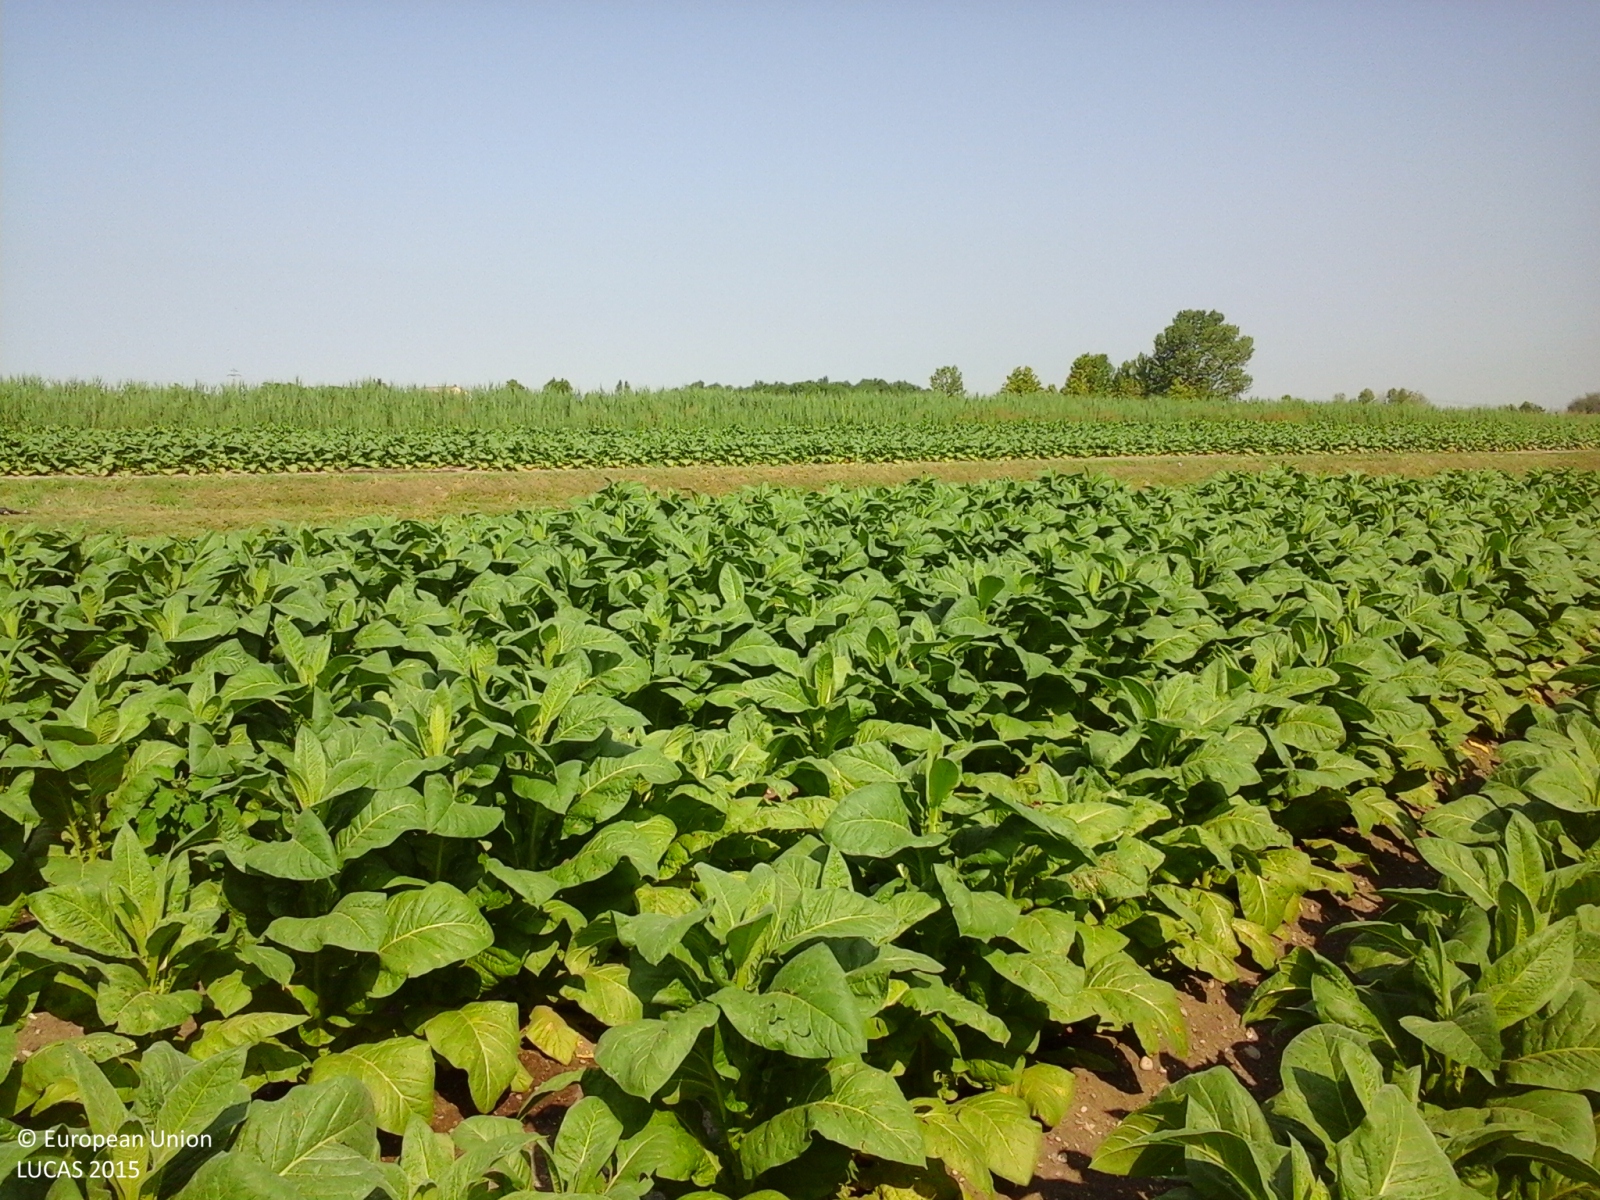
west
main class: Cropland
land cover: Tobacco
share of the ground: > 75 %
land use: Agriculture (excluding fallow land and kitchen gardens)
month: July
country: IT
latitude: 45.3191
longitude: 11.0315
